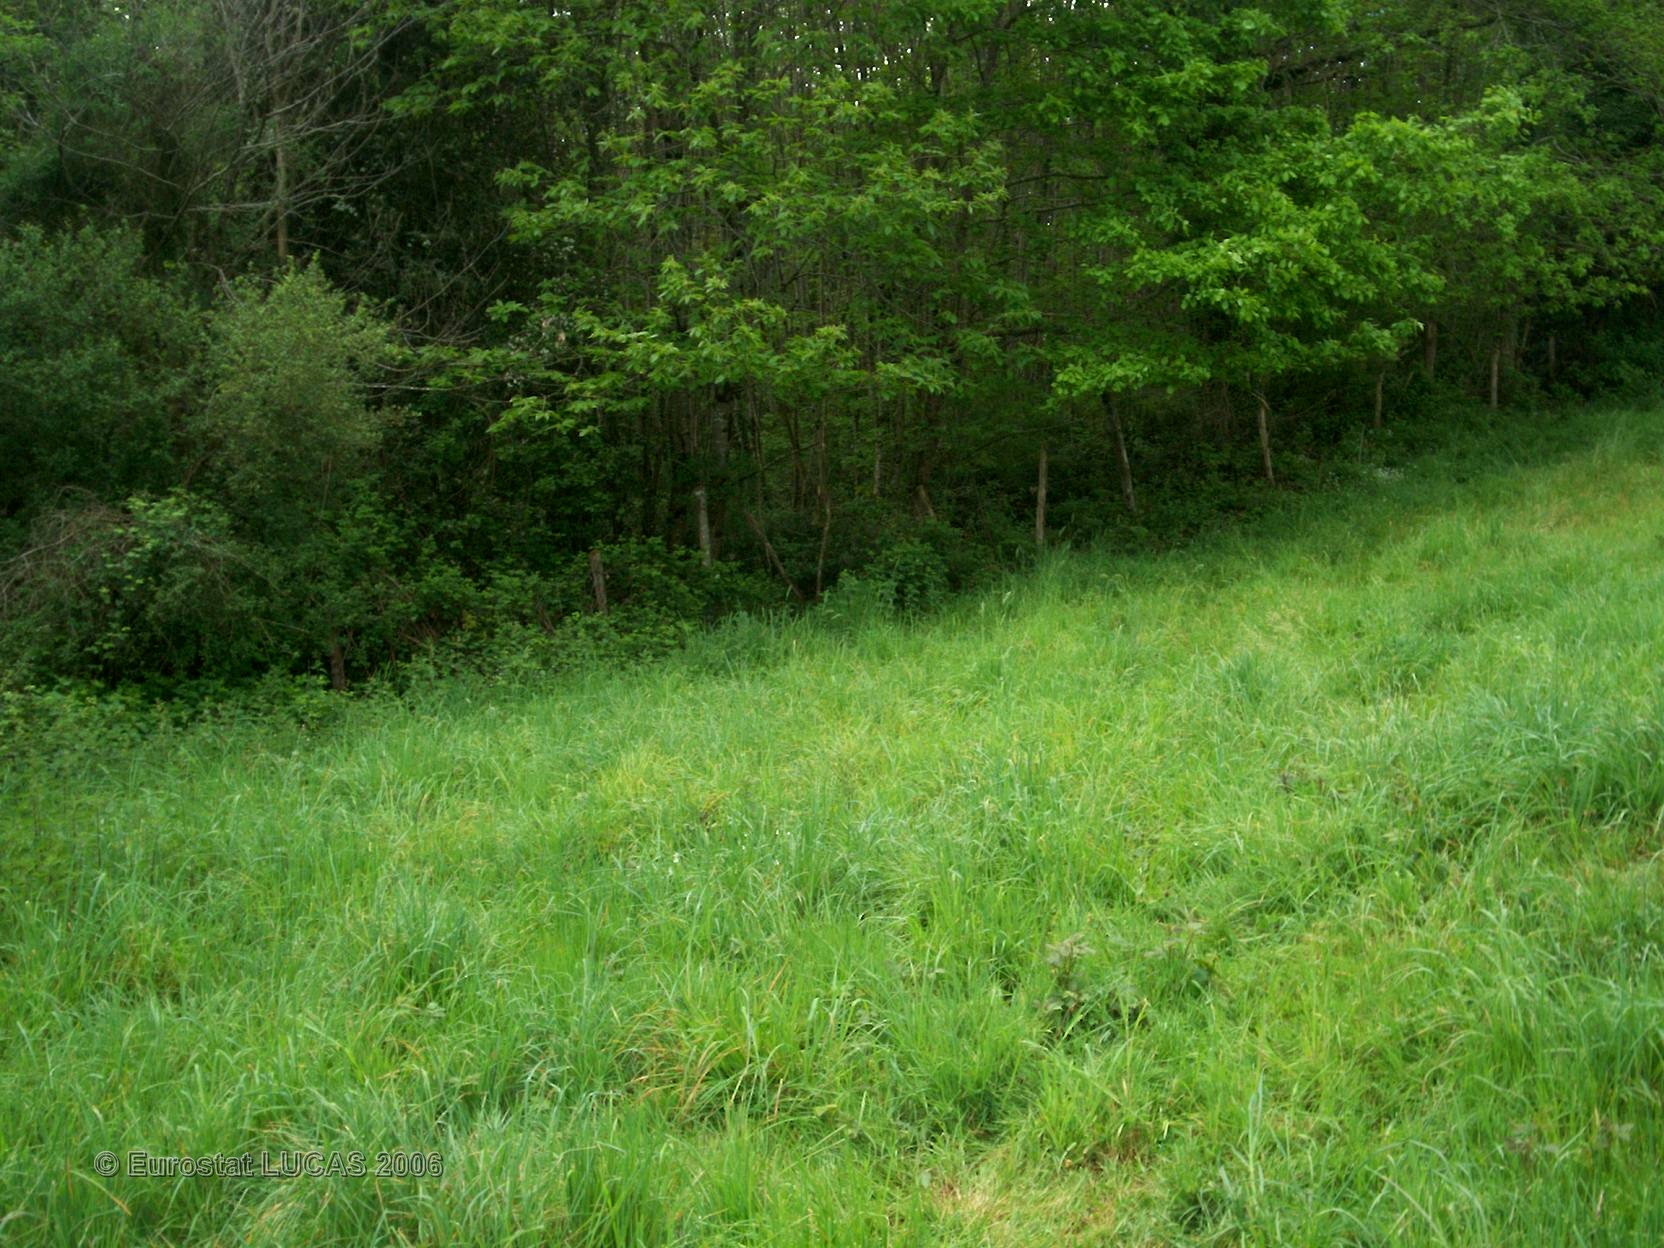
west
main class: Grassland
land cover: Grassland without tree/shrub cover
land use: Agriculture (excluding fallow land and kitchen gardens)
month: May
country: FR
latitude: 45.9771
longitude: 0.4461
